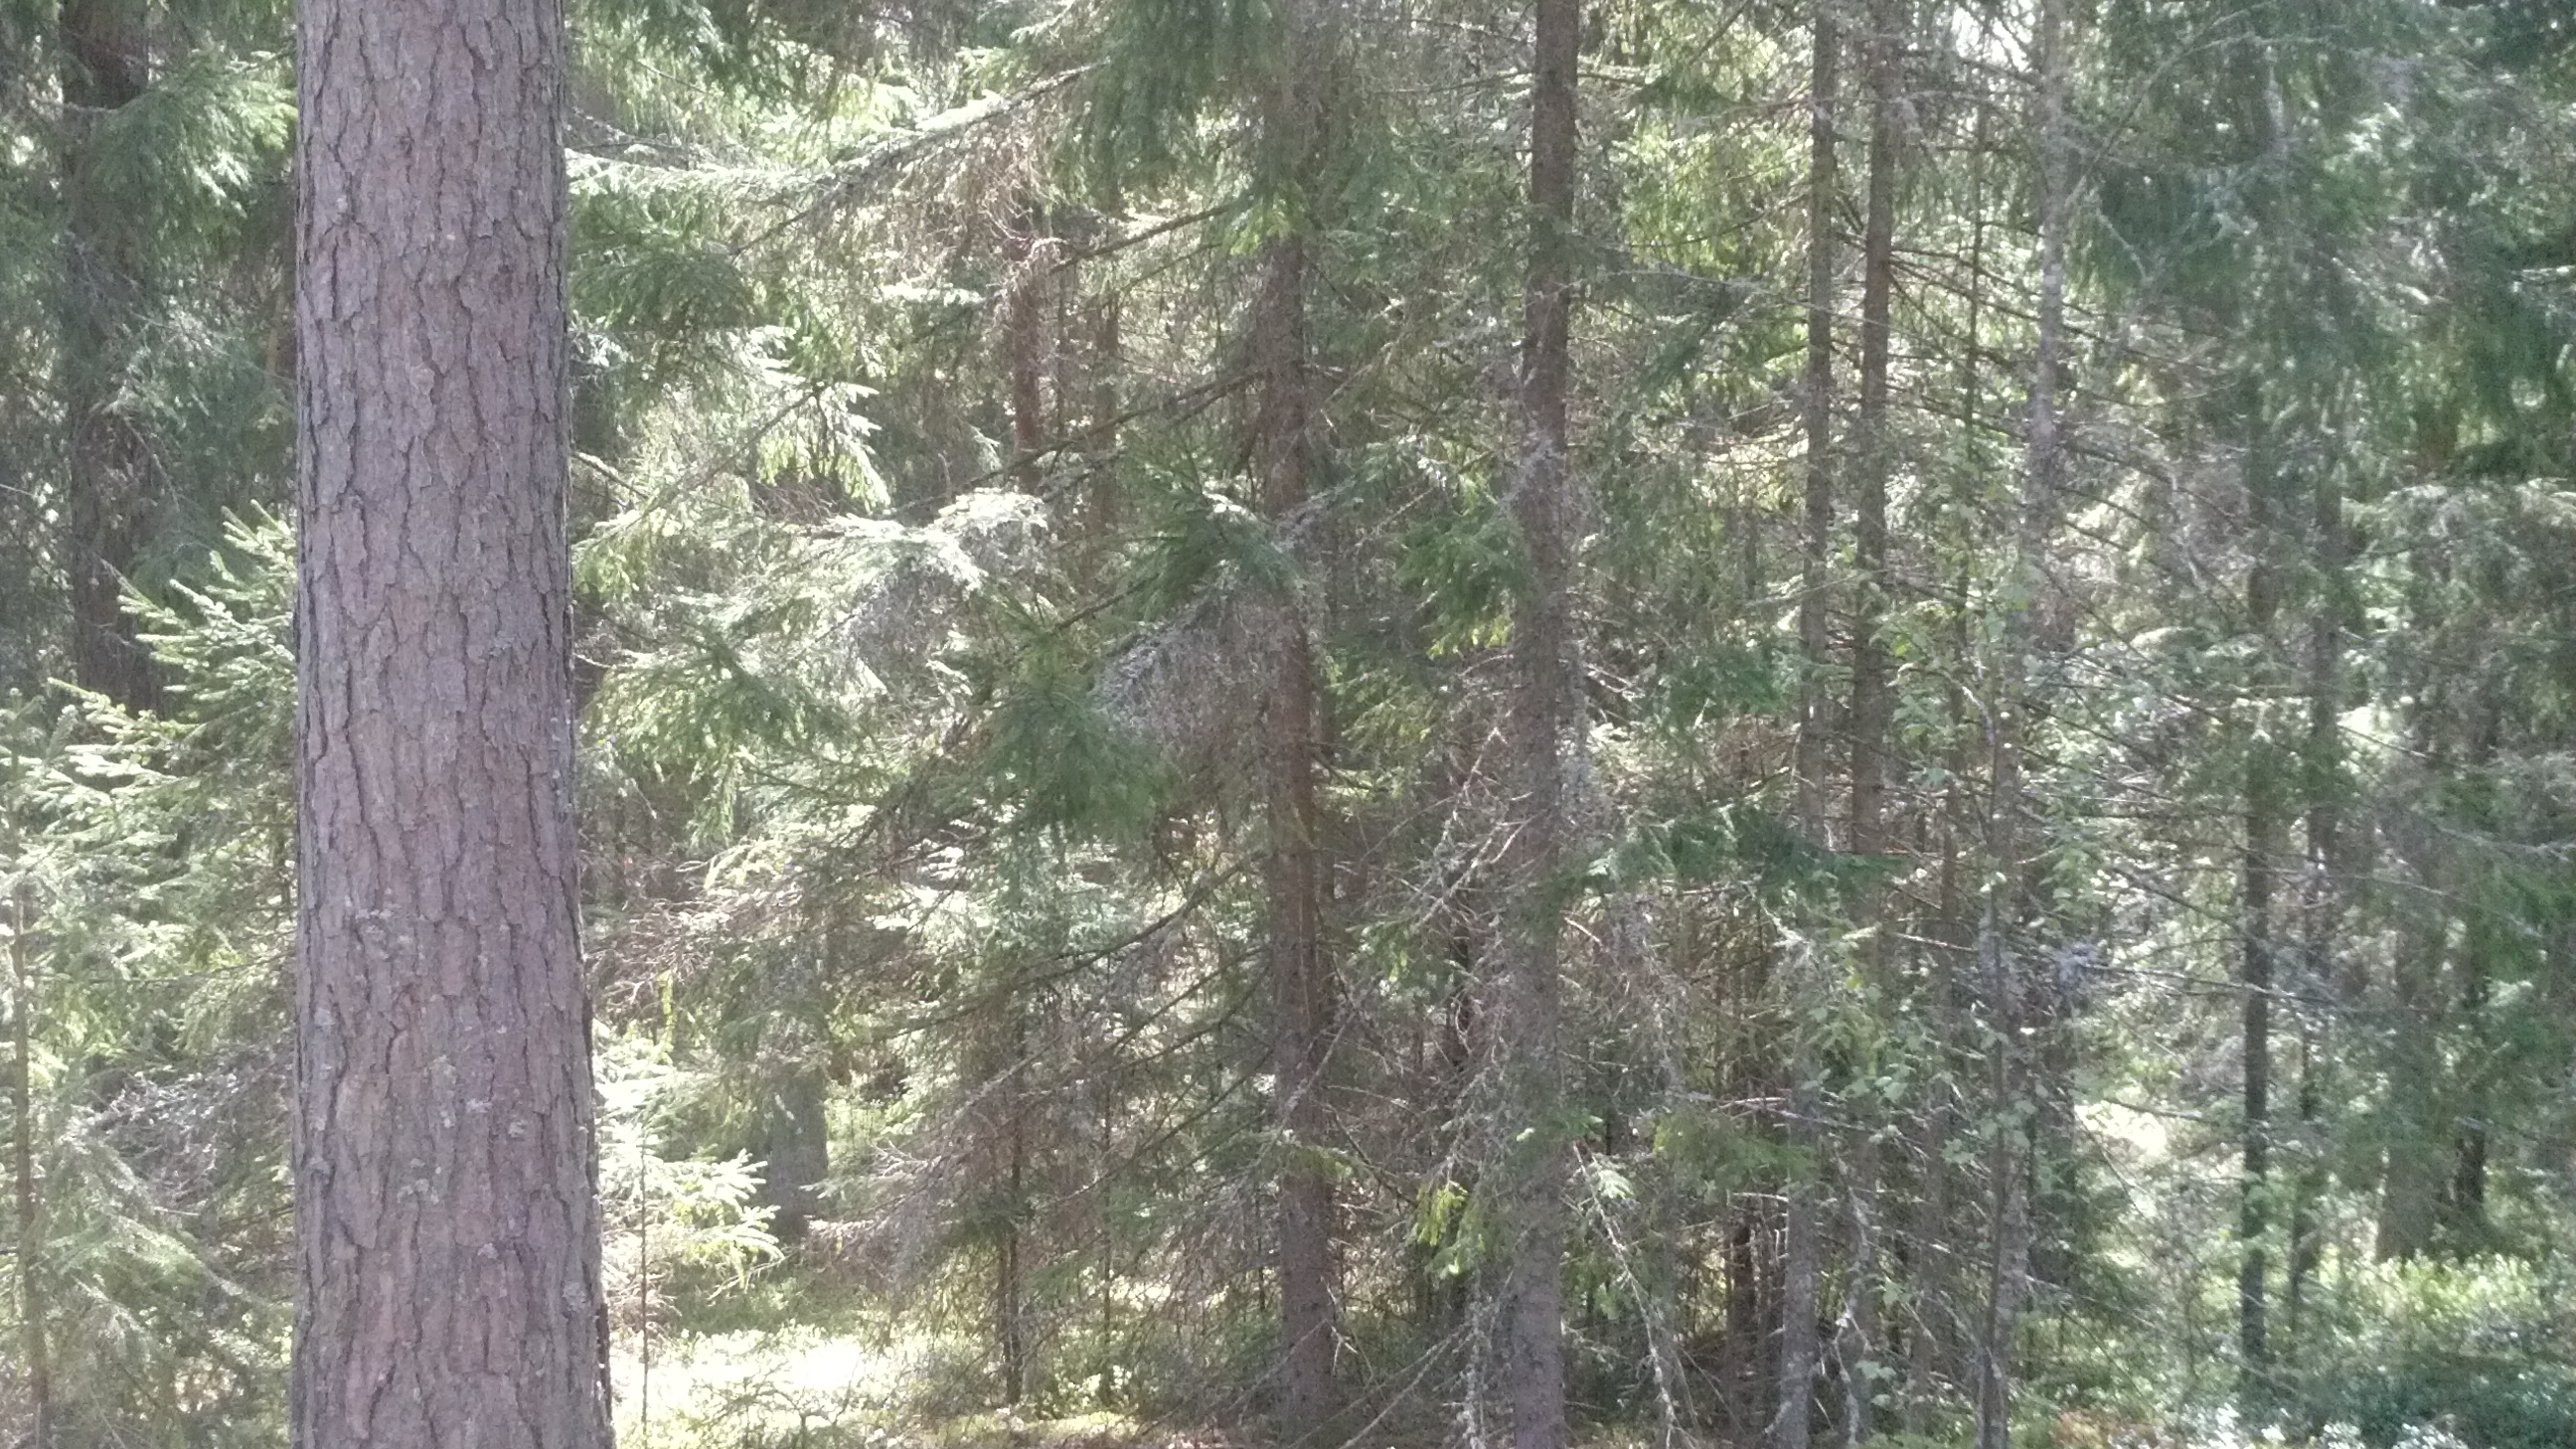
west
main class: Woodland
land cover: Pine dominated coniferous woodland
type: hemiboreal forest and nemoral coniferous forest and mixed broadleaved-coniferous forest
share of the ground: > 75 %
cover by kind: coniferous forest trees 100 %
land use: Forestry
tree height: > 5 m
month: May
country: LV
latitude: 55.8844
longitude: 27.2975
